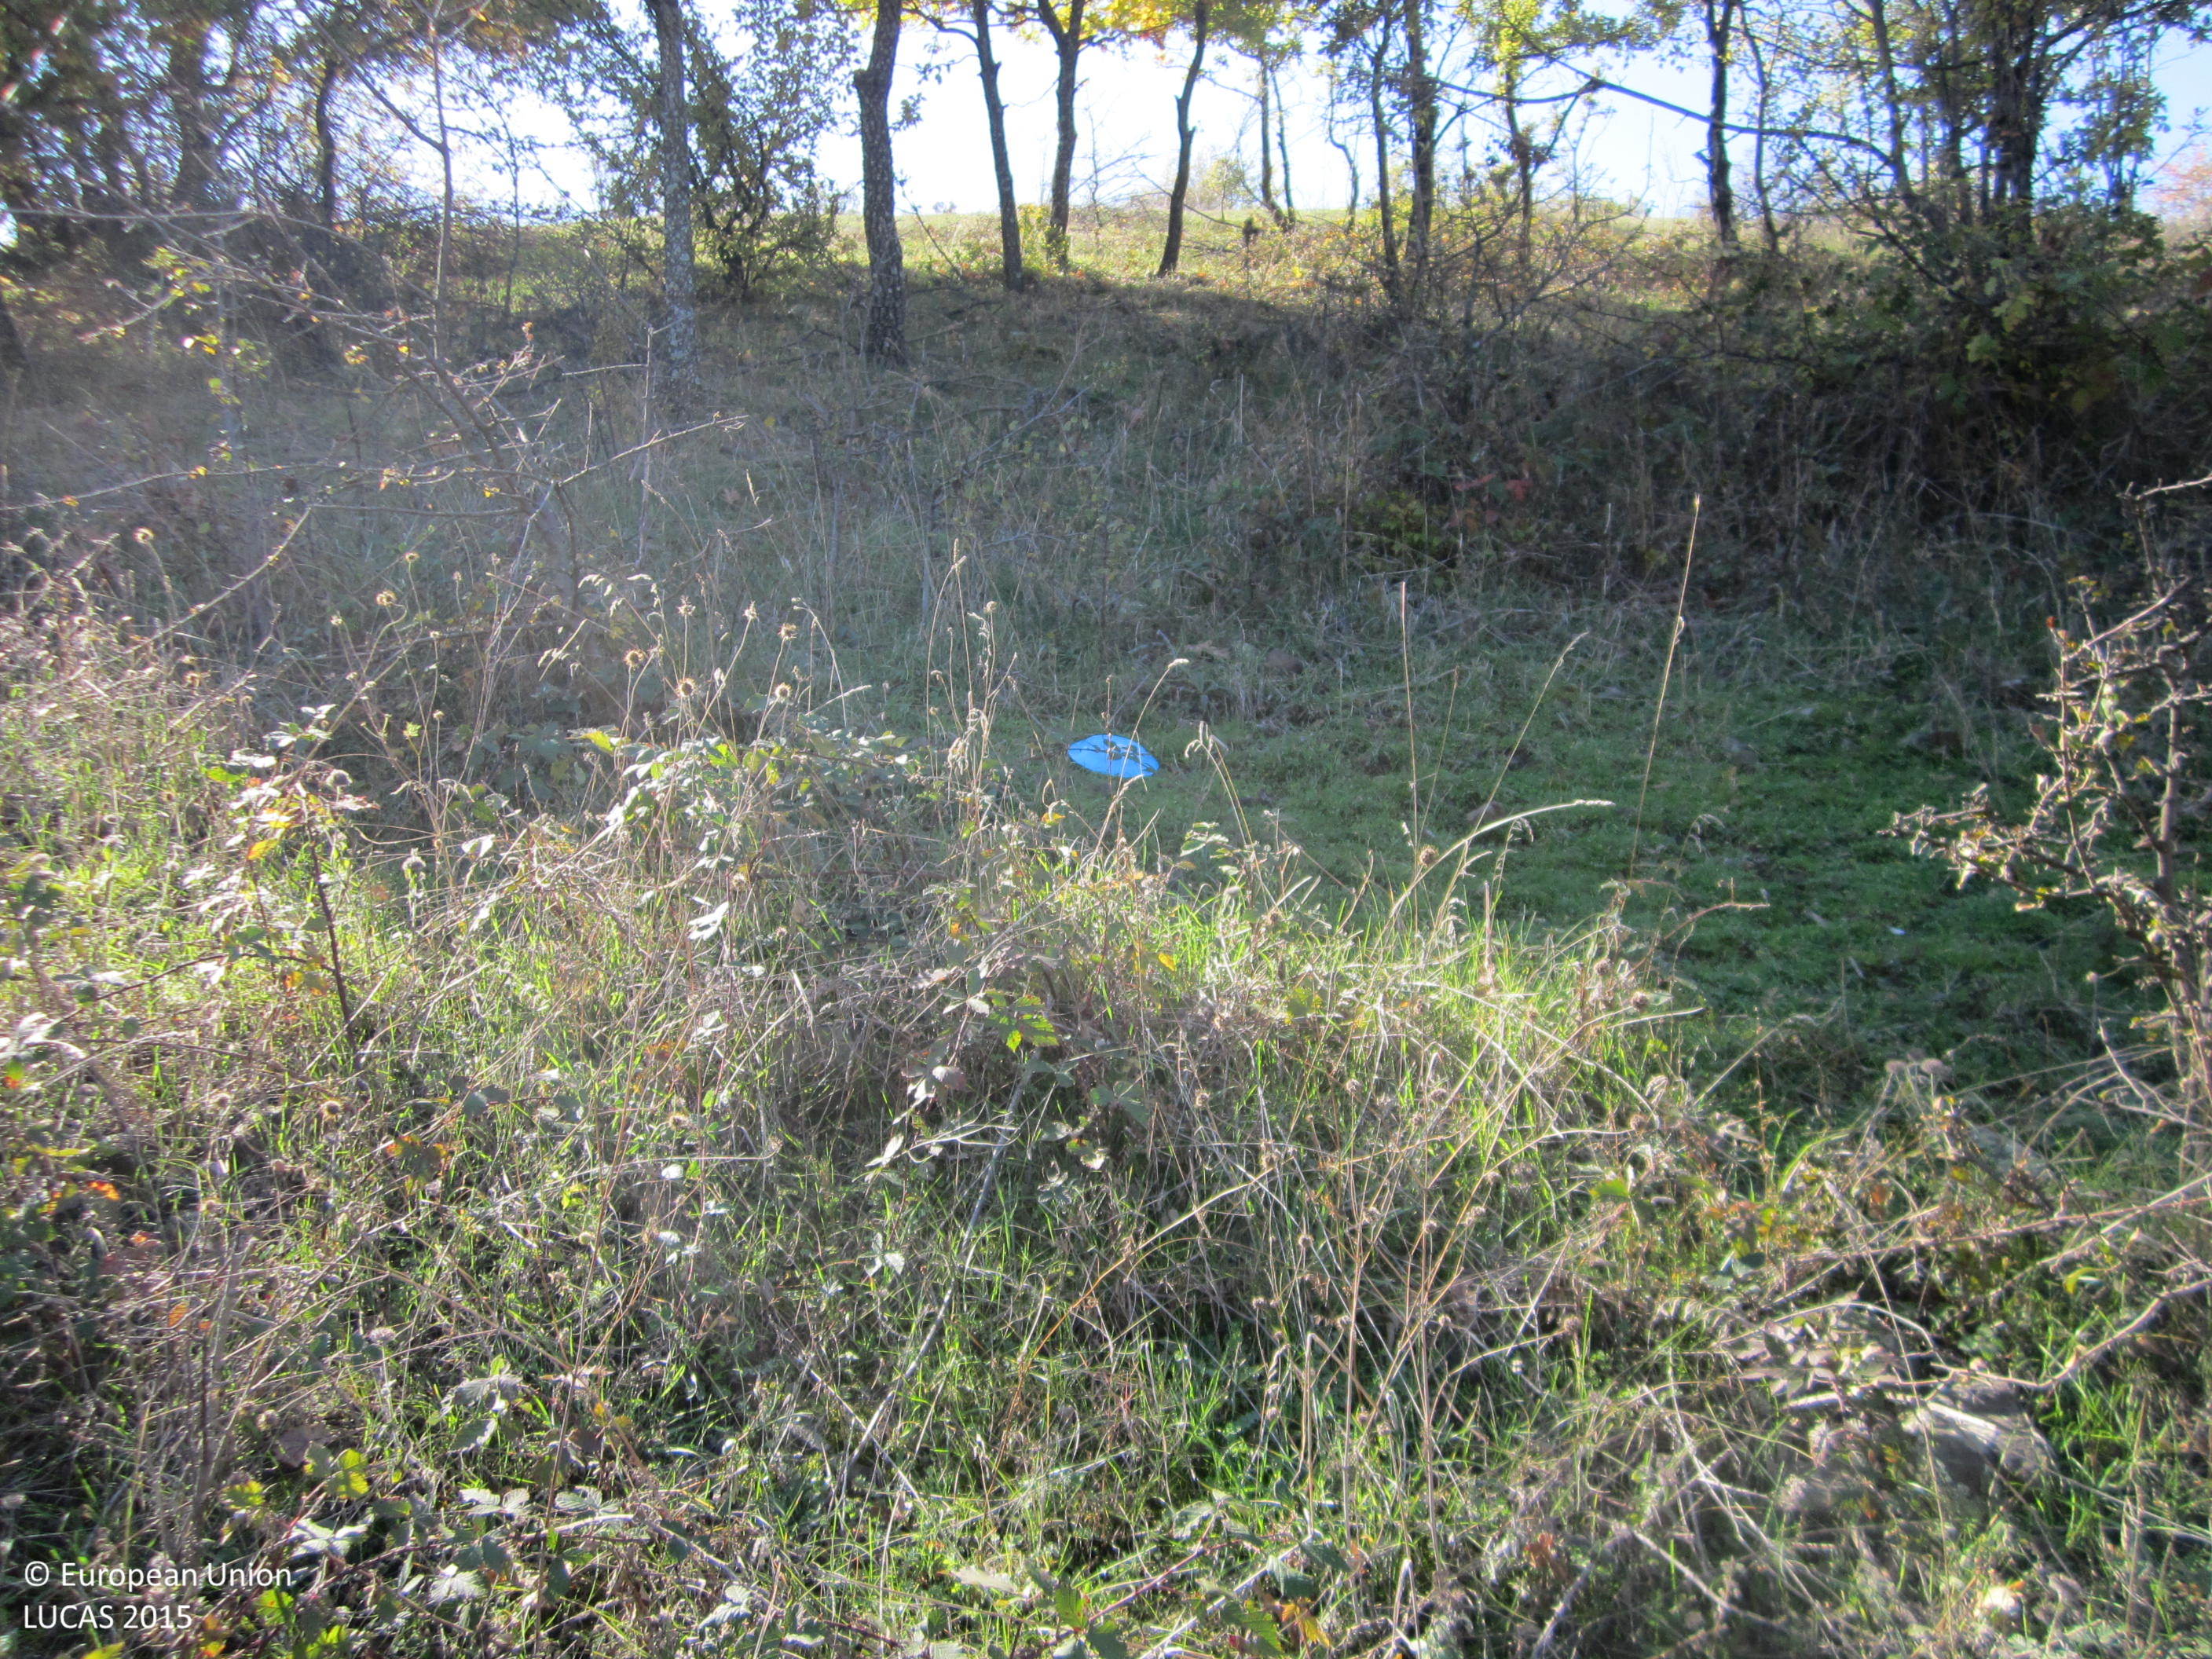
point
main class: Woodland
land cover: Broadleaved woodland
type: acidophilous oak and oak-birch forest
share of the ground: 50 - 75 %
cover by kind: broadleaved forest trees 60 %, herbaceous plants 30 %, shrubs 10 %
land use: Forestry
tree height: > 5 m
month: November
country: BG
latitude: 41.5315
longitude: 25.5805
